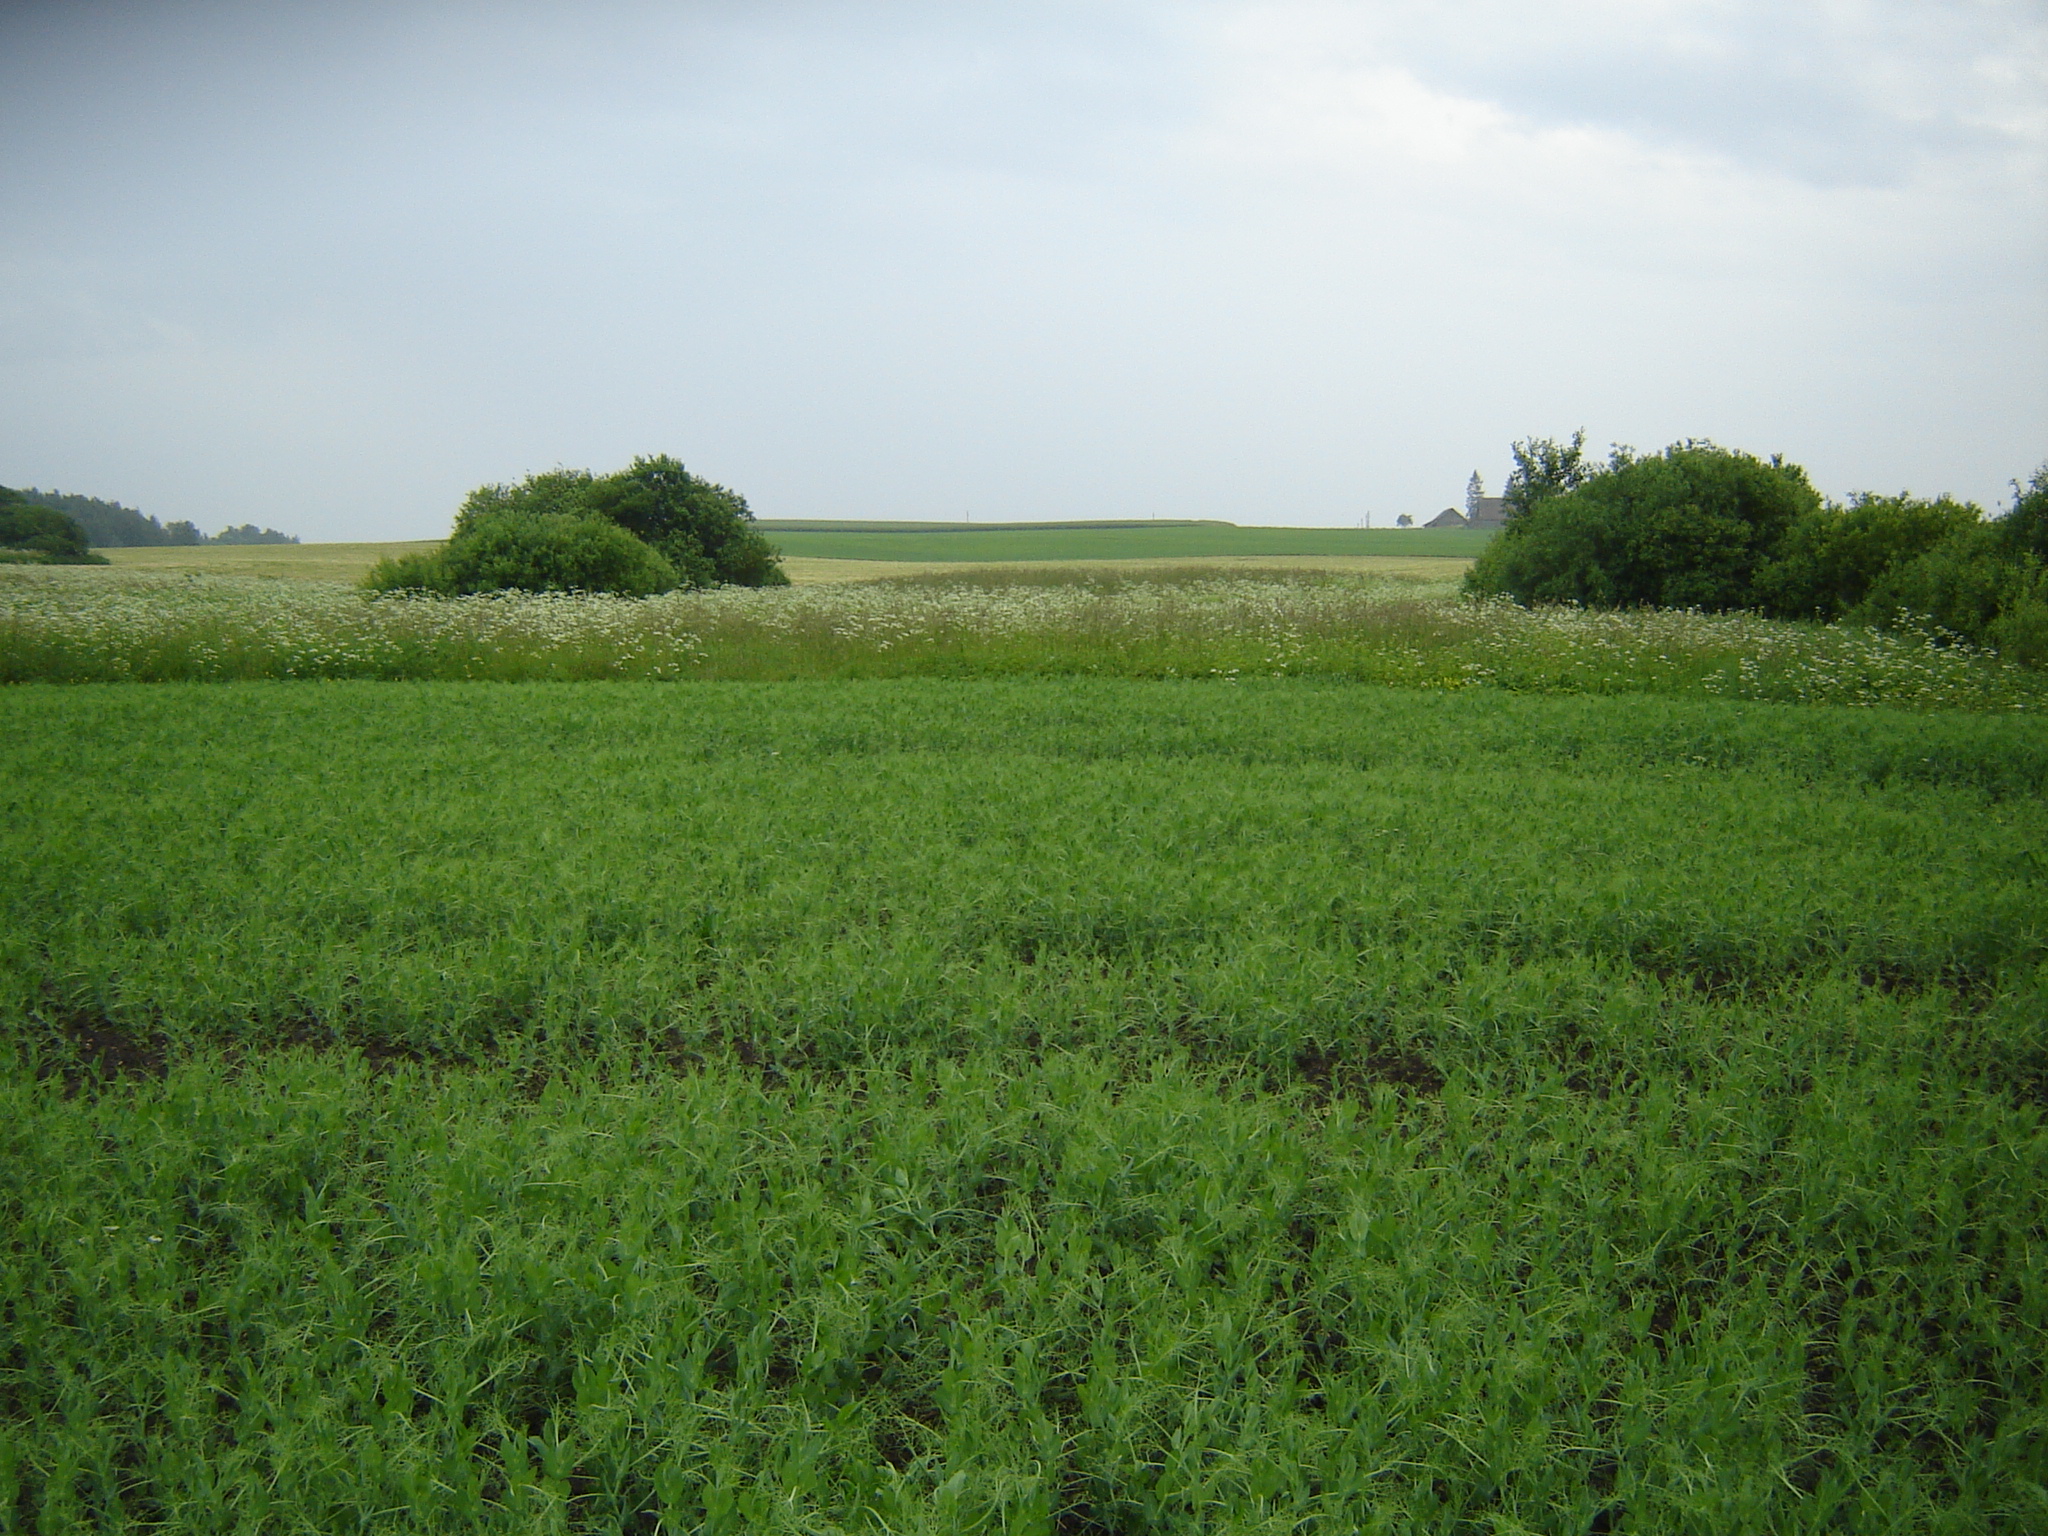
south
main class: Cropland
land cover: Dry pulses
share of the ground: > 75 %
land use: Agriculture (excluding fallow land and kitchen gardens)
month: June
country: LT
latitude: 55.5606
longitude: 25.2596
